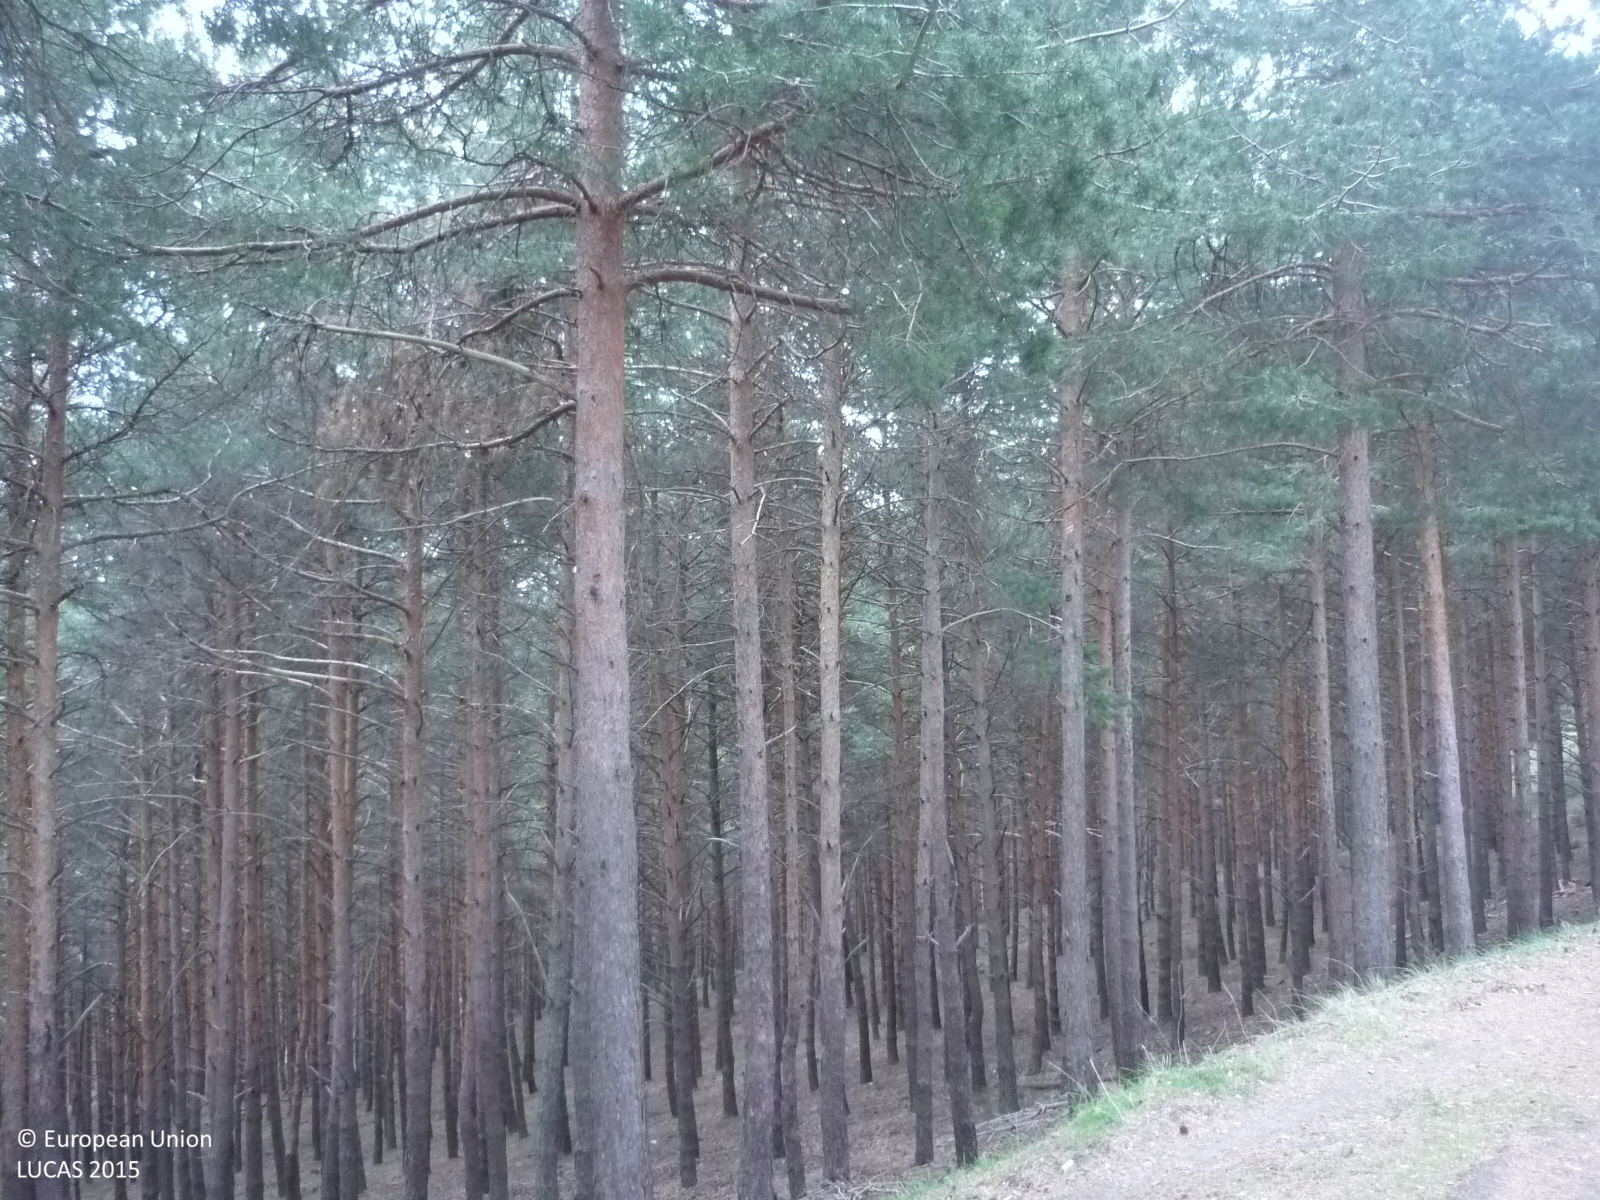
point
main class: Woodland
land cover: Pine dominated coniferous woodland
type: coniferous forest of the mediterranean region
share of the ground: > 75 %
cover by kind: coniferous forest trees 85 %, shrubs 10 %, herbaceous plants 5 %
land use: Forestry
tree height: > 5 m
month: May
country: ES
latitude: 41.0571
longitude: -3.4521
